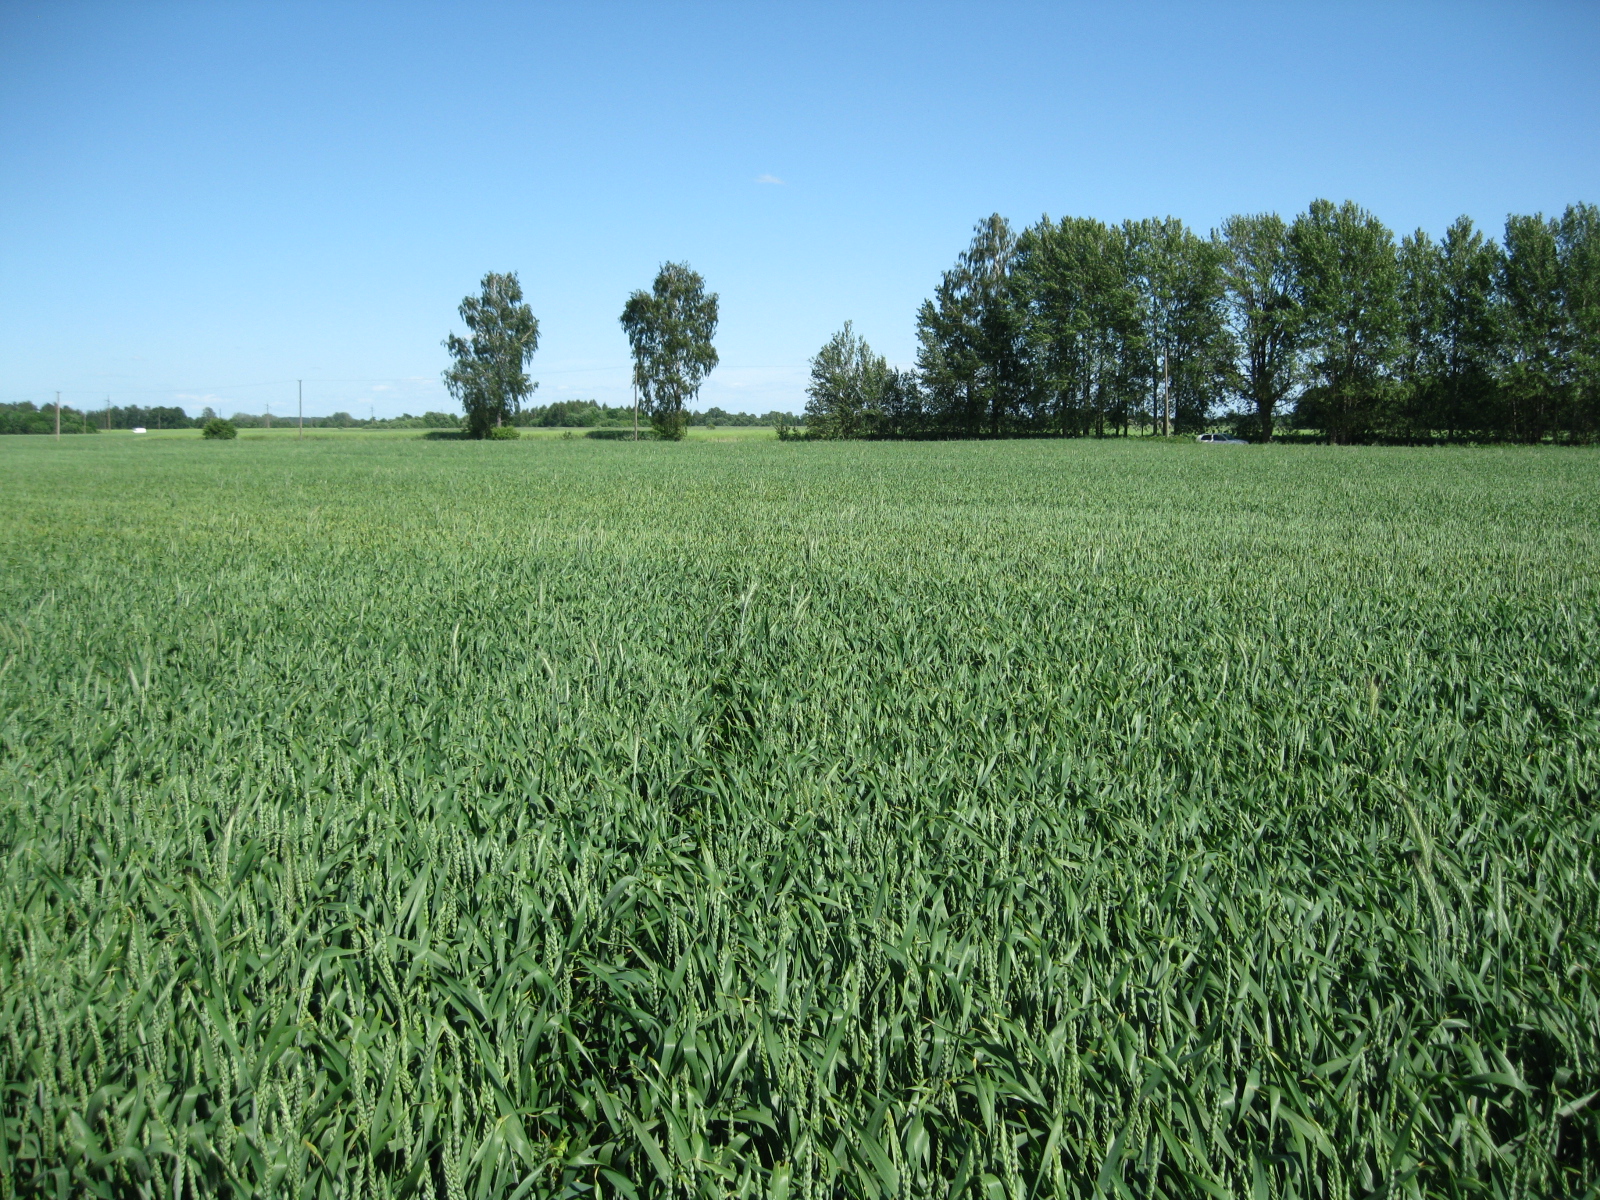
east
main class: Cropland
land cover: Common wheat
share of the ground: > 75 %
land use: Agriculture (excluding fallow land and kitchen gardens)
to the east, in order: Common wheat; Shruby margins; Electric lines; Grass margins; Paved roads, cycling and walking lanes; Grassland with sparse tree/shrub cover; Rape and turnip rape
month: June
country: LT
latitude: 55.2557
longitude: 23.7893
